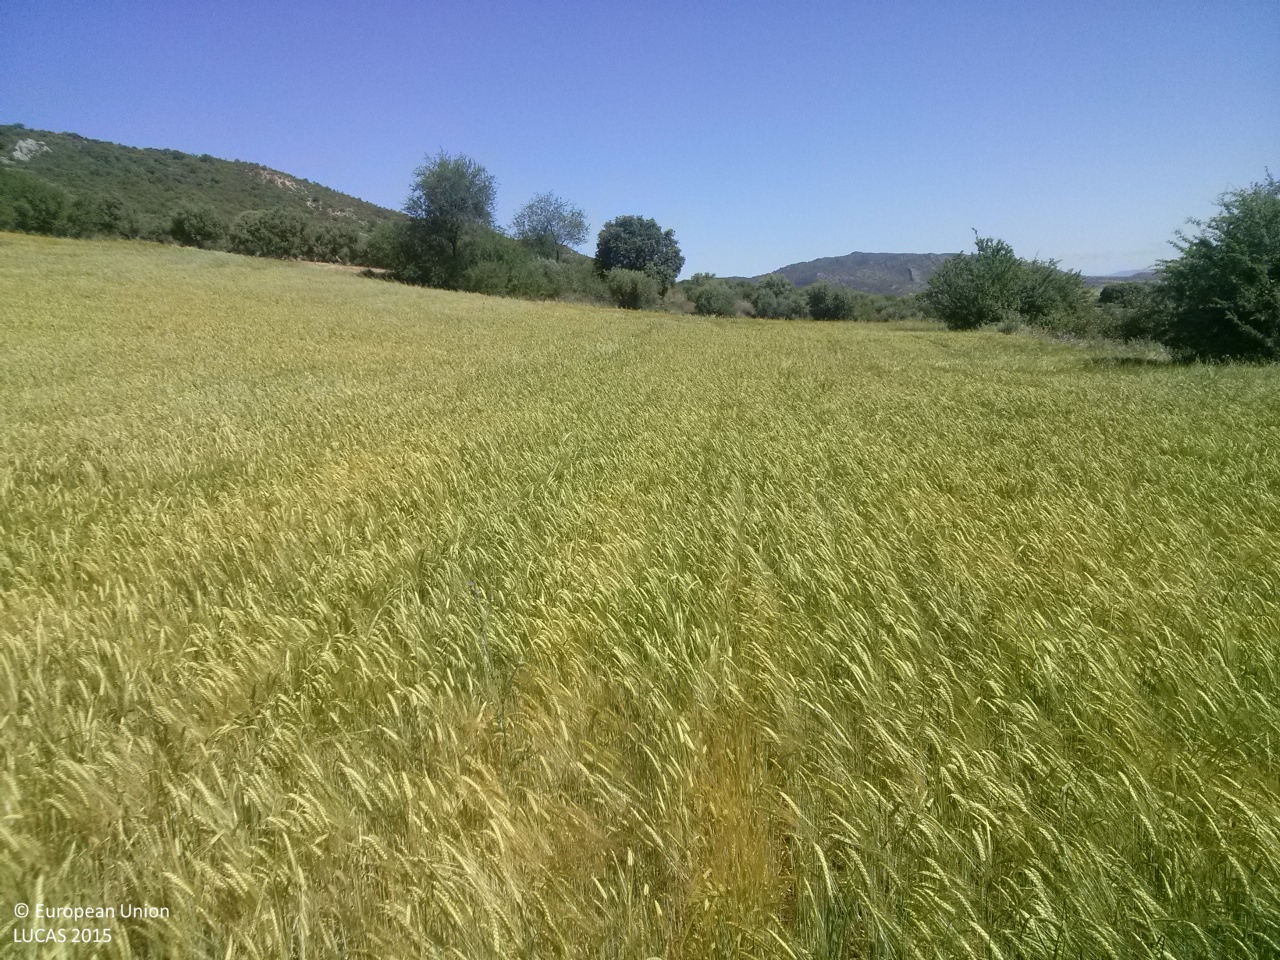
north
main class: Cropland
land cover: Barley
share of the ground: > 75 %
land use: Agriculture (excluding fallow land and kitchen gardens)
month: May
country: ES
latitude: 40.1736
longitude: -2.8119
